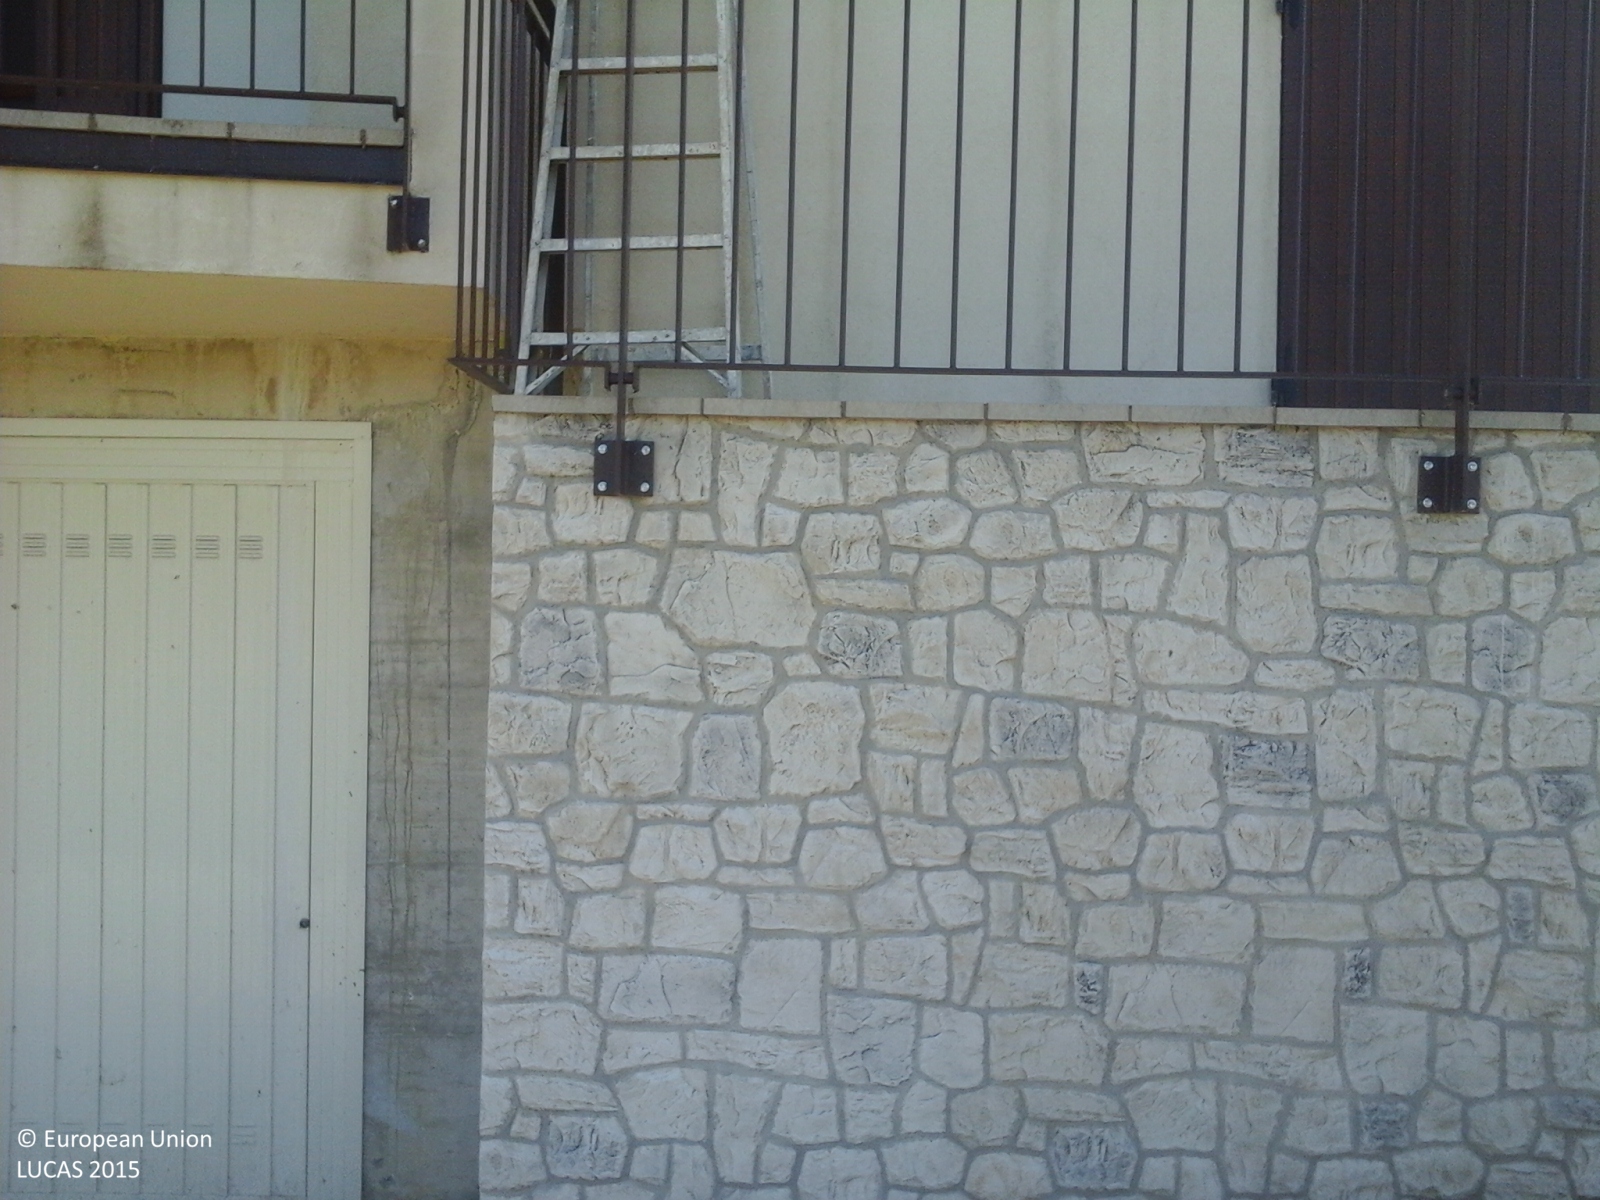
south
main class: Cropland
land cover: Lucerne
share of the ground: > 75 %
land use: Agriculture (excluding fallow land and kitchen gardens)
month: June
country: IT
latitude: 44.4750
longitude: 10.6146
